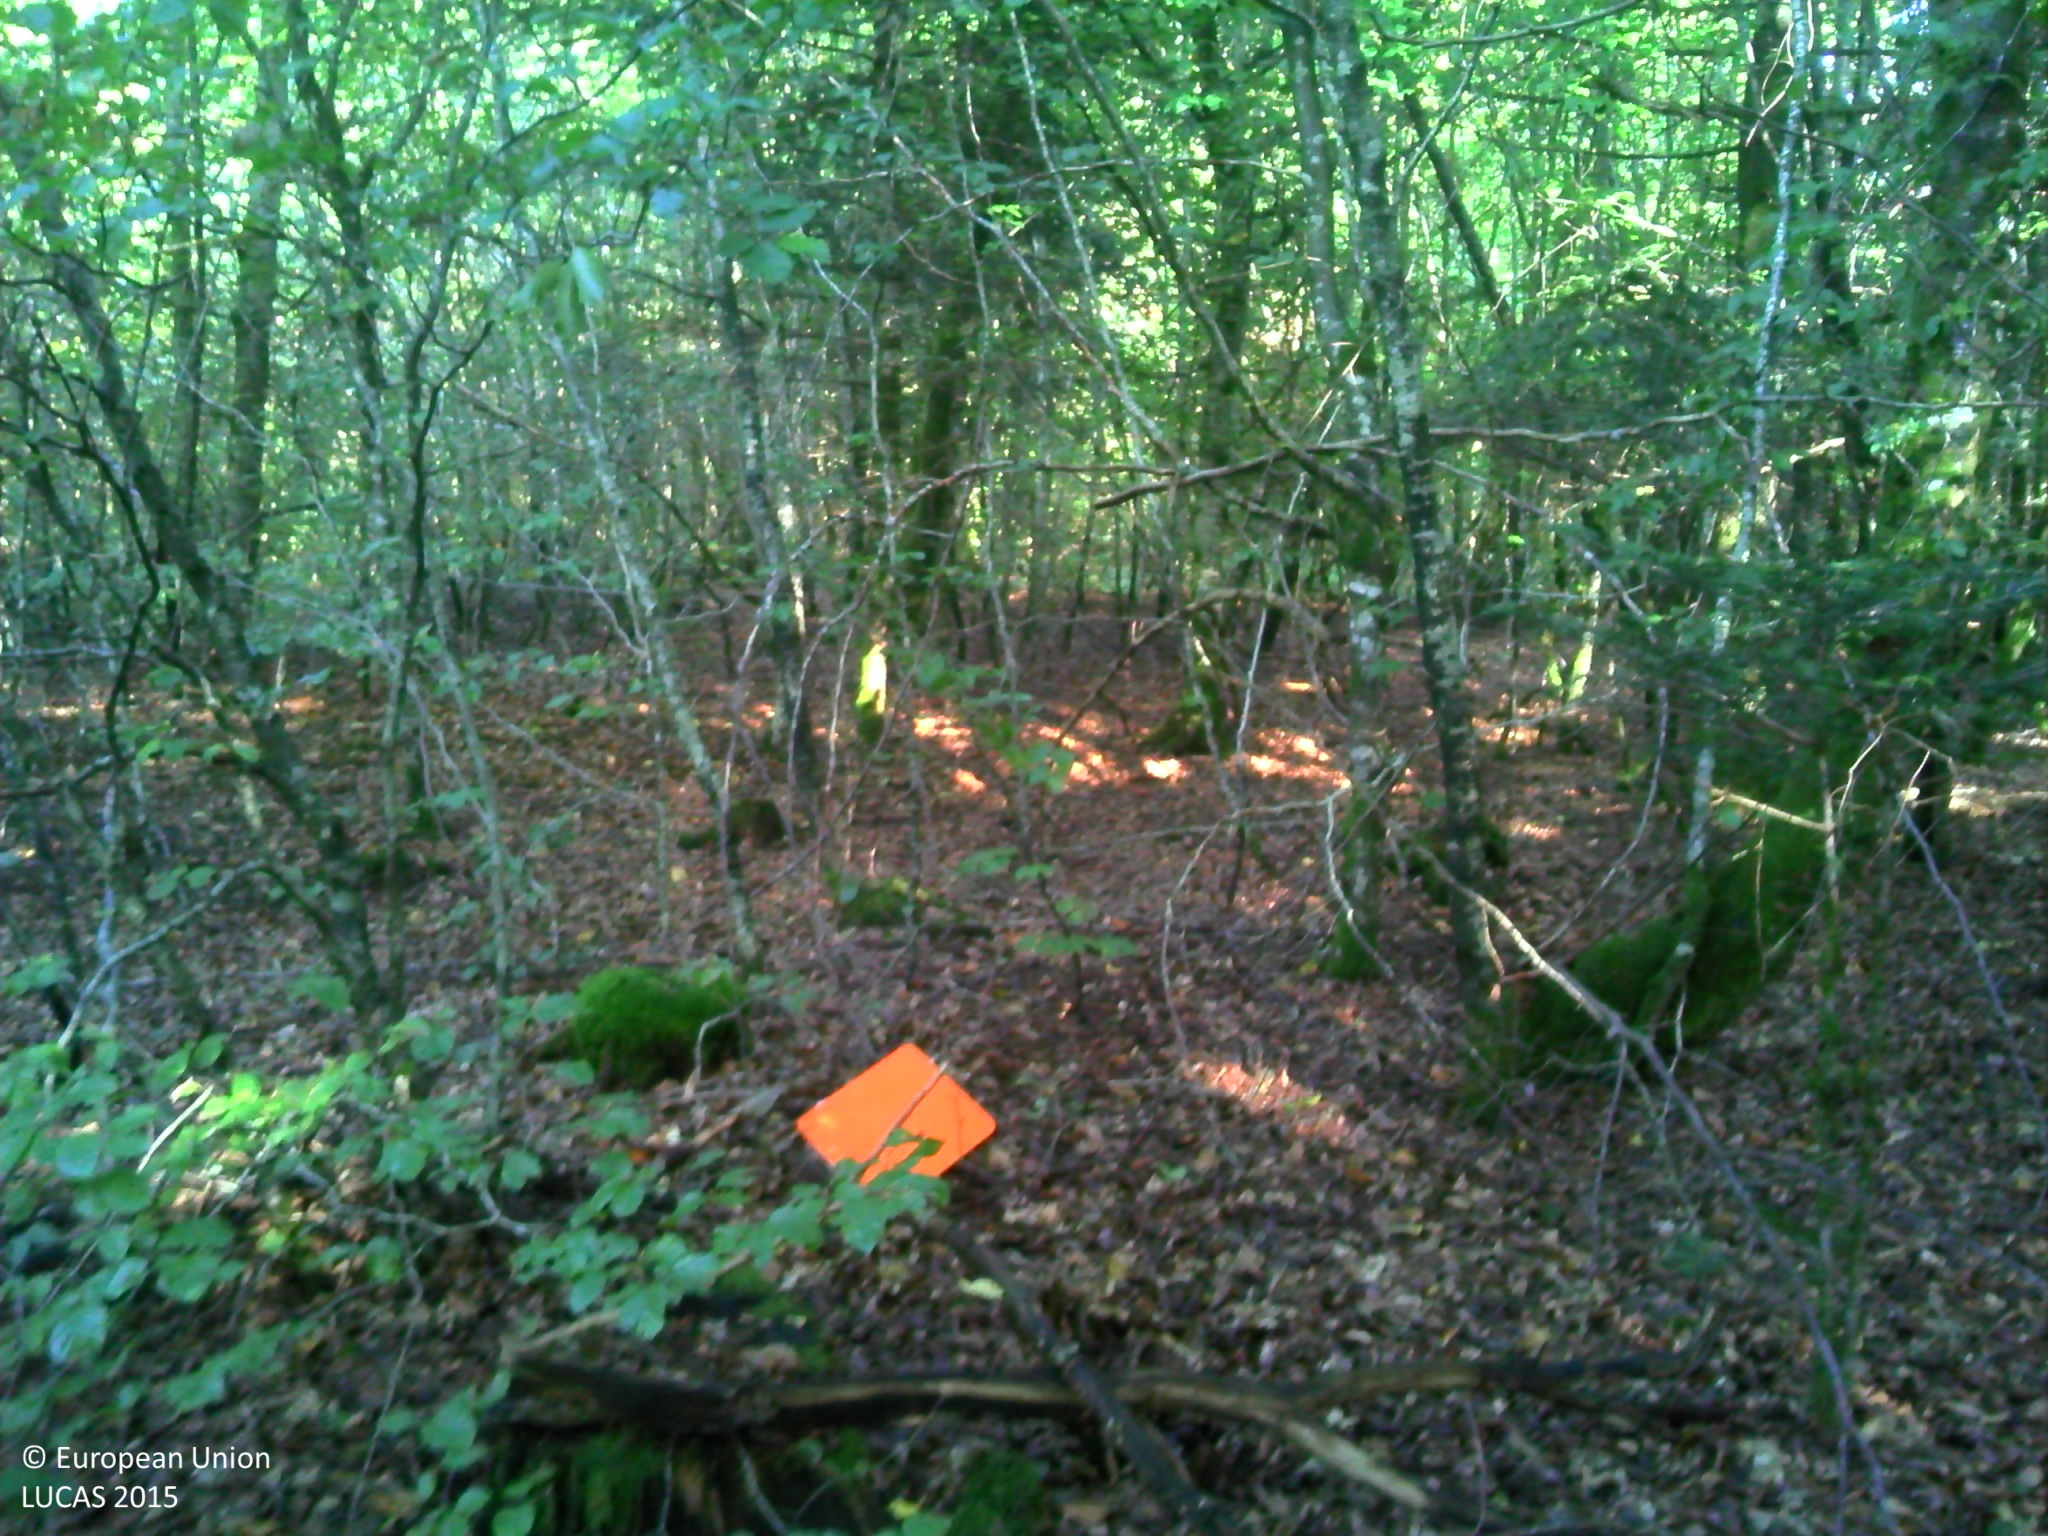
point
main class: Woodland
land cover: Broadleaved woodland
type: beech forest
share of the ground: > 75 %
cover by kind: broadleaved forest trees 85 %, consolidated bare surface 10 %, herbaceous plants 5 %
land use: Forestry
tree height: > 5 m
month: September
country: FR
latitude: 48.4472
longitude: 6.7965
